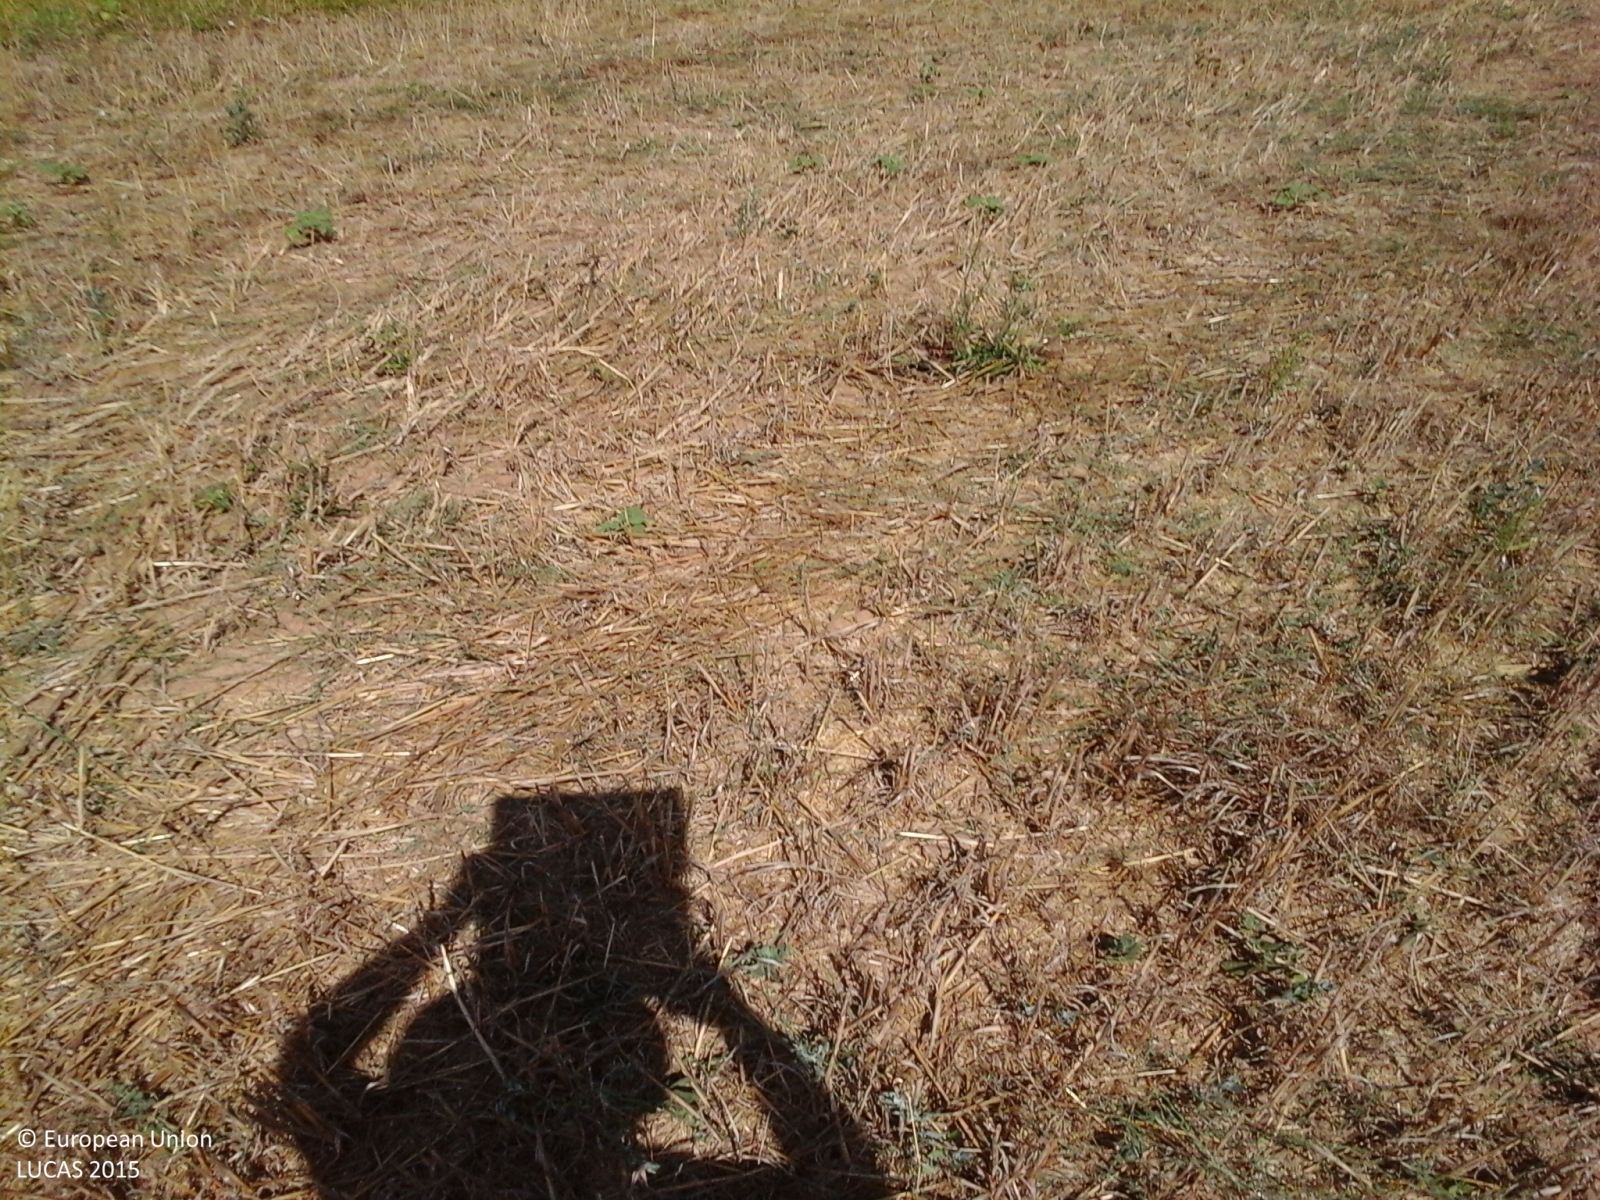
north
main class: Cropland
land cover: Barley
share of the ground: > 75 %
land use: Agriculture (excluding fallow land and kitchen gardens)
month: August
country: IT
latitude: 42.5354
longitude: 11.4439
